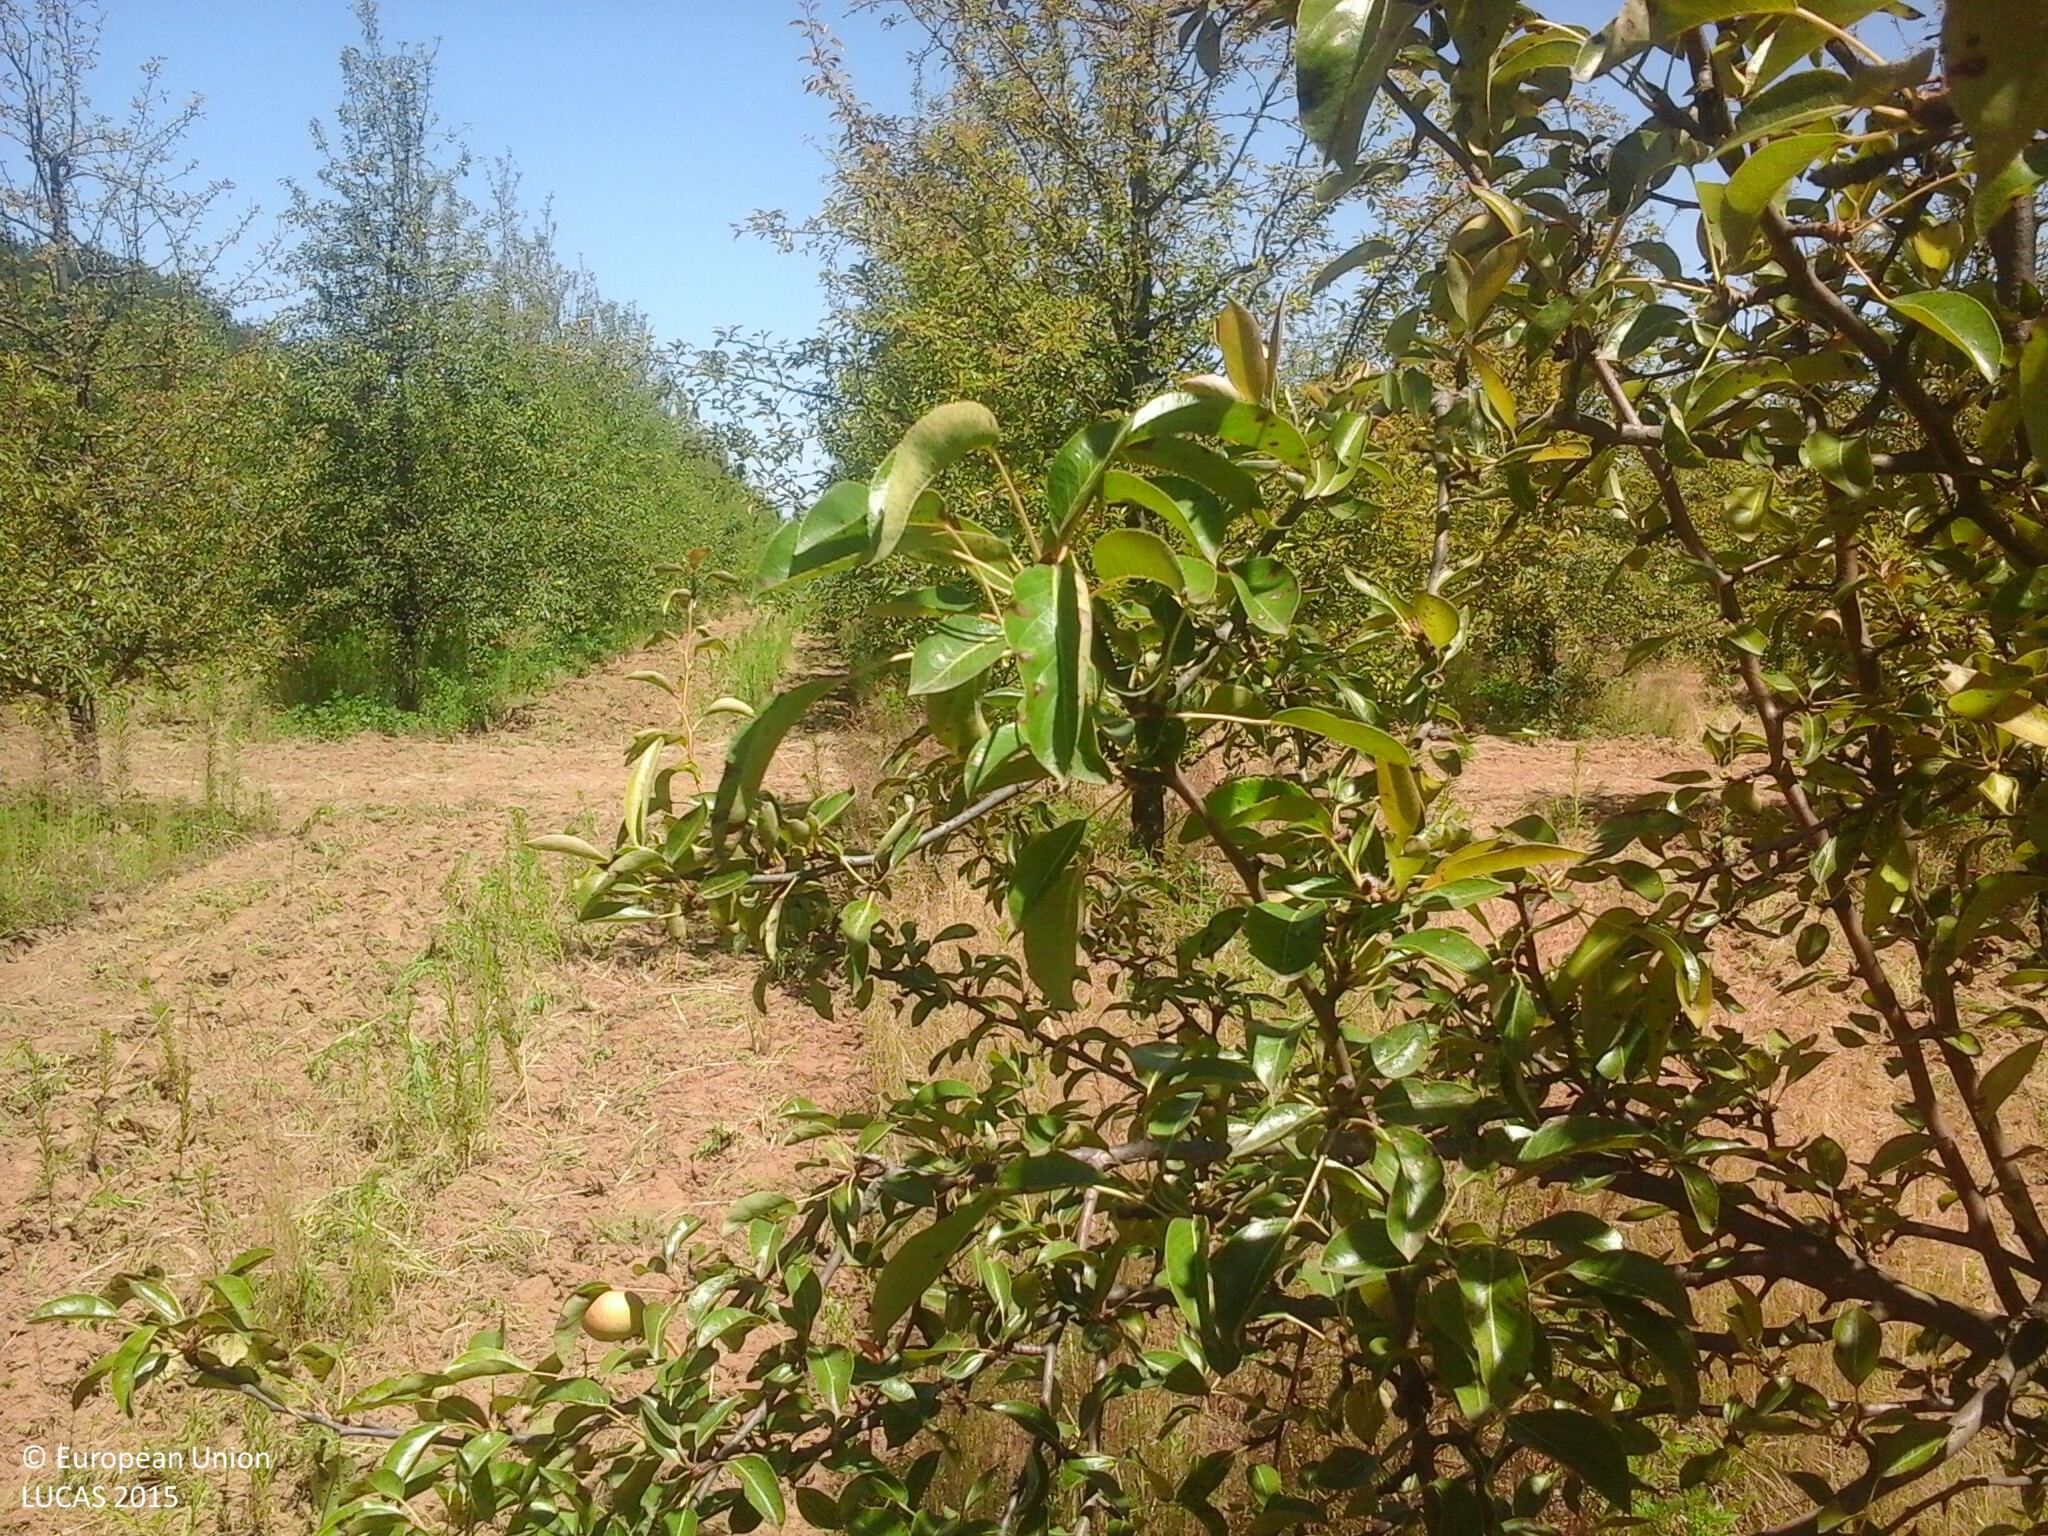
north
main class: Cropland
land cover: Pear fruit
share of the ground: 10 - 25 %
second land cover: Grassland without tree/shrub cover
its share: 50 - 75 %
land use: Agriculture (excluding fallow land and kitchen gardens)
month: July
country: HU
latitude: 47.8248
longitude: 21.7895
